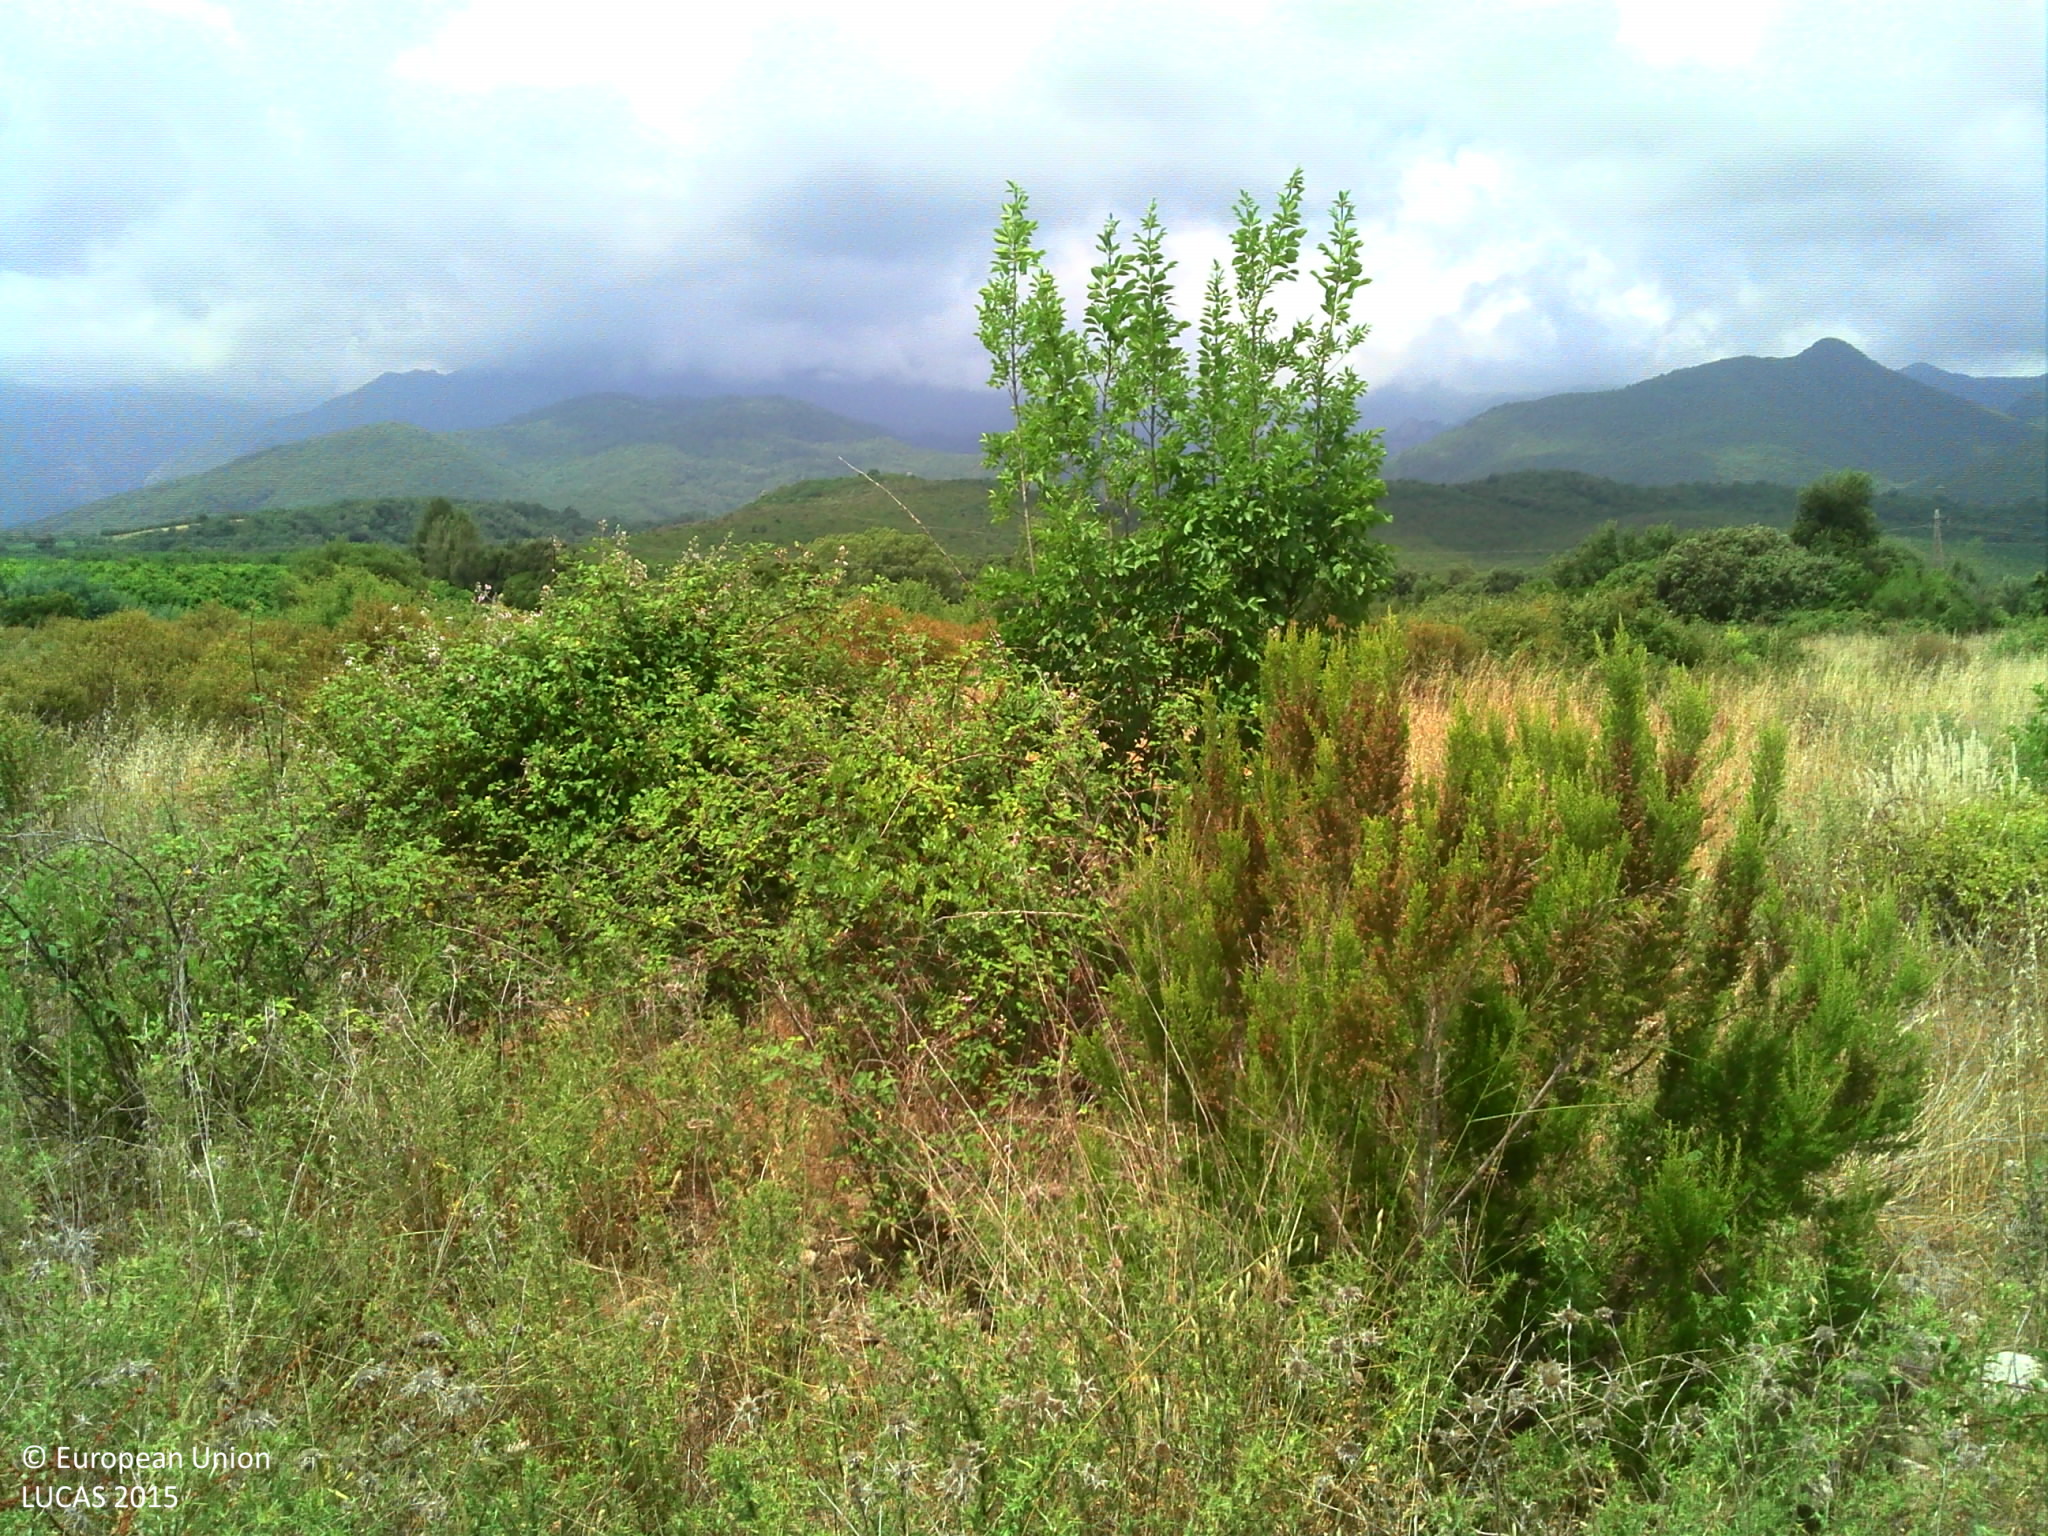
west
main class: Shrubland
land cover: Shrubland without tree cover
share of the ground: > 75 %
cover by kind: shrubs 85 %, herbaceous plants 15 %
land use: Agriculture (excluding fallow land and kitchen gardens)
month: July
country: FR
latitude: 42.0558
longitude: 9.3620
